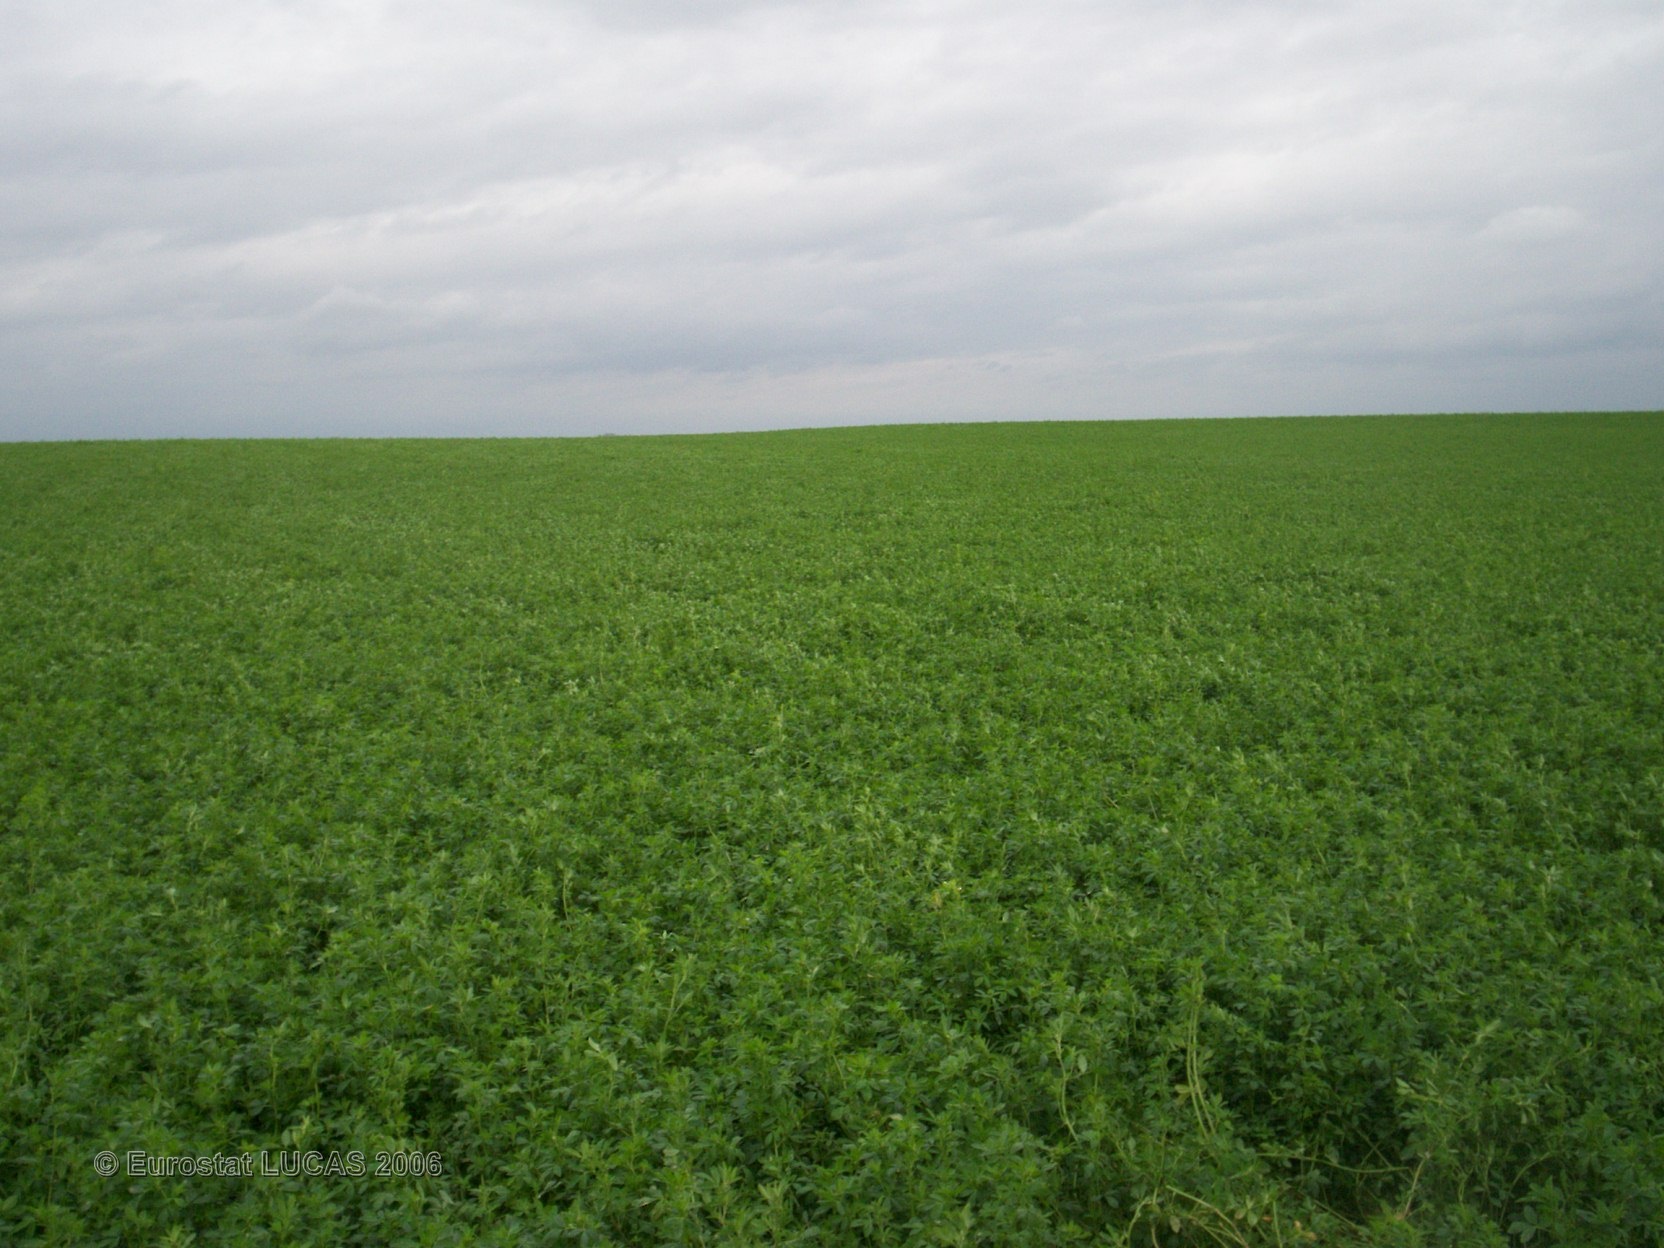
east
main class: Cropland
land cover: Lucerne
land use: Agriculture (excluding fallow land and kitchen gardens)
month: May
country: FR
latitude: 49.3943
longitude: 4.3330
